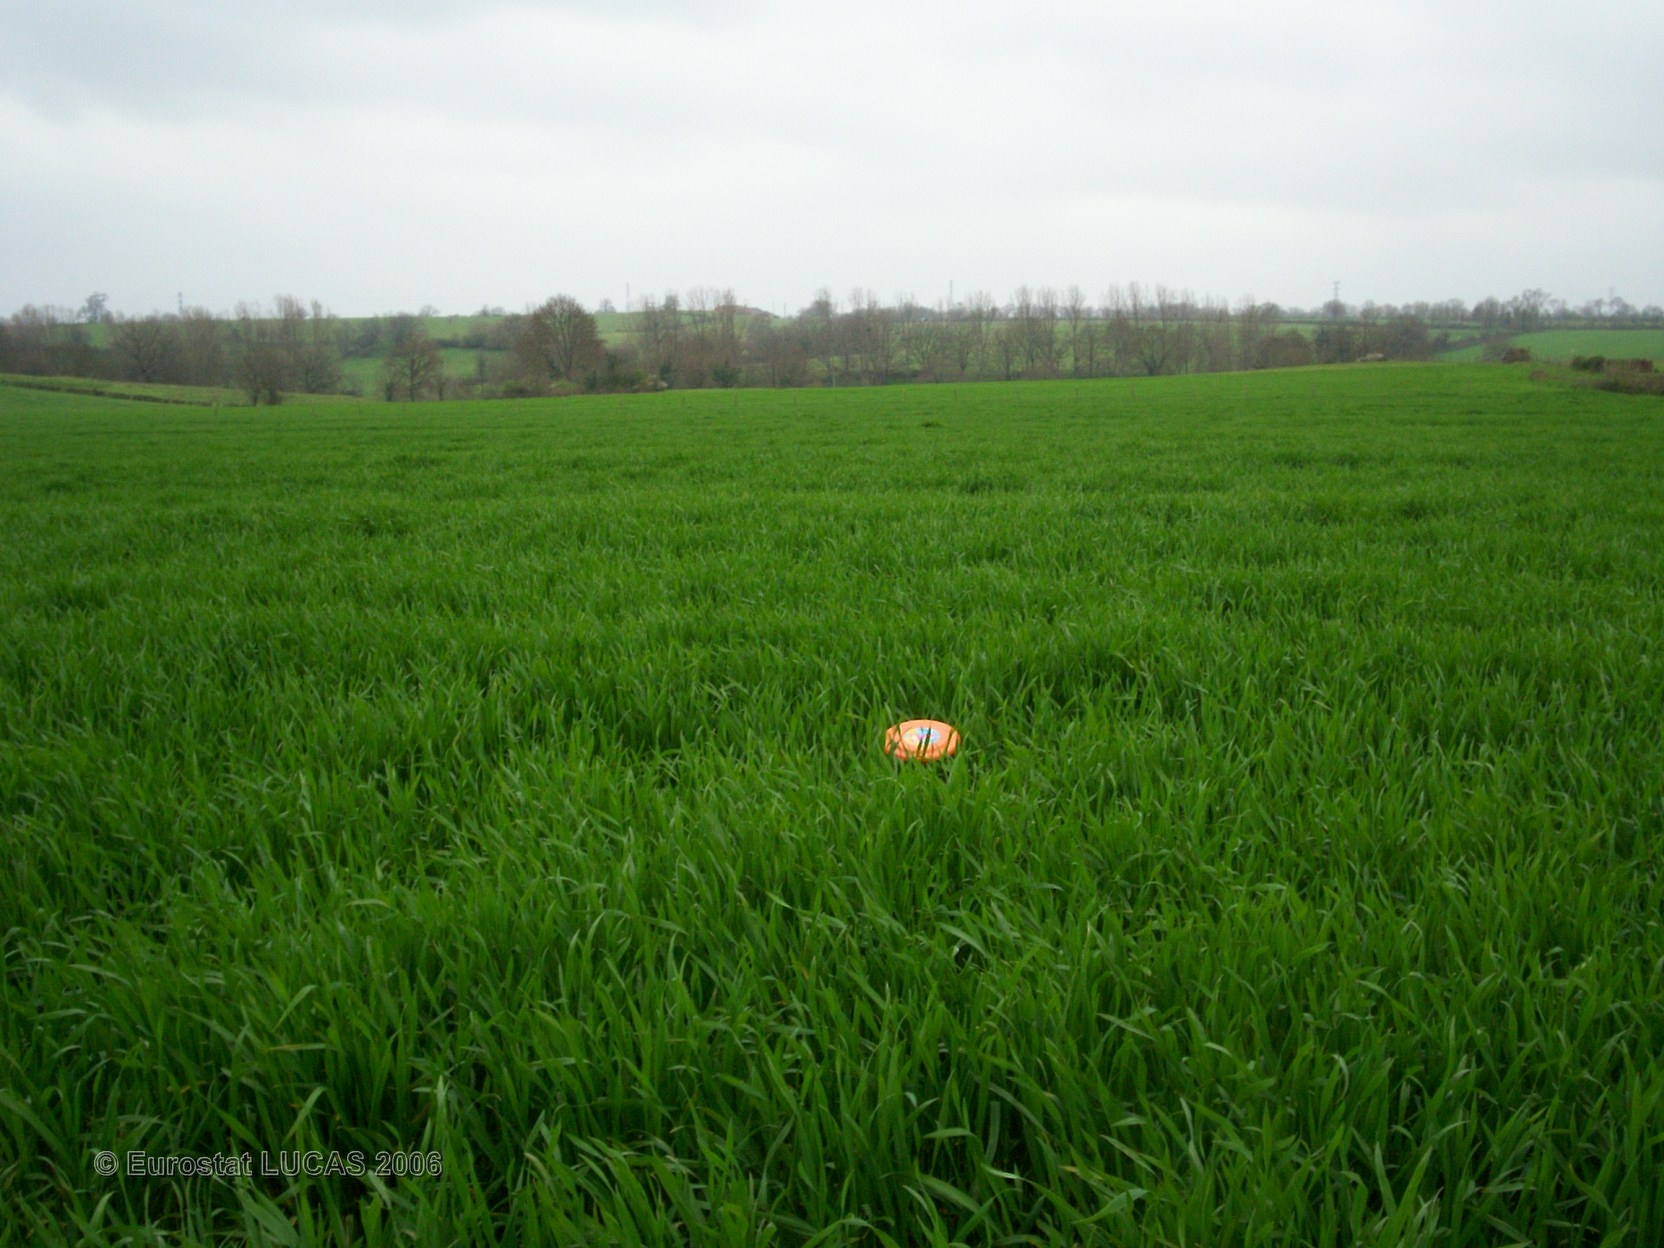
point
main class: Cropland
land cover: Common wheat
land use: Agriculture (excluding fallow land and kitchen gardens)
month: April
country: FR
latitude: 46.8488
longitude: -0.3210
